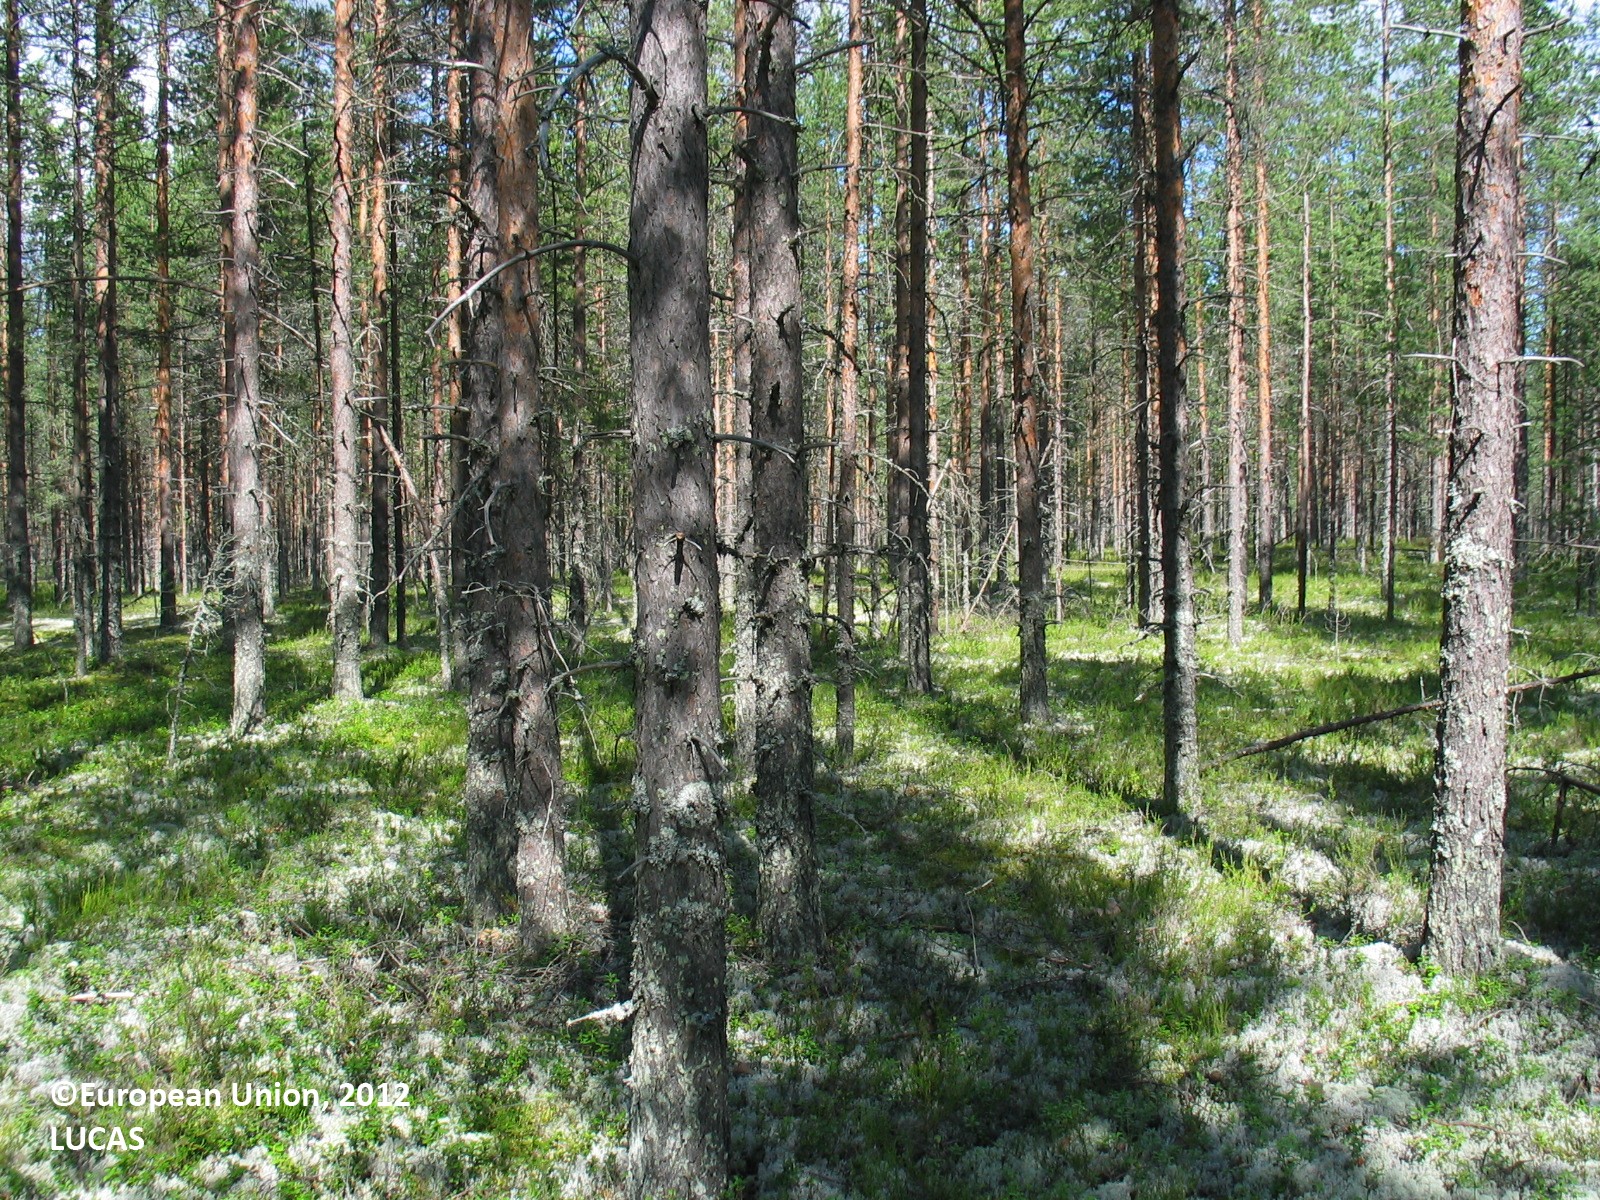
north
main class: Woodland
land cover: Pine dominated coniferous woodland
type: boreal forest
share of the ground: 25 - 50 %
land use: Amenities, museums, leisure
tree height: > 5 m
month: July
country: FI
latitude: 64.5860
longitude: 26.4648
